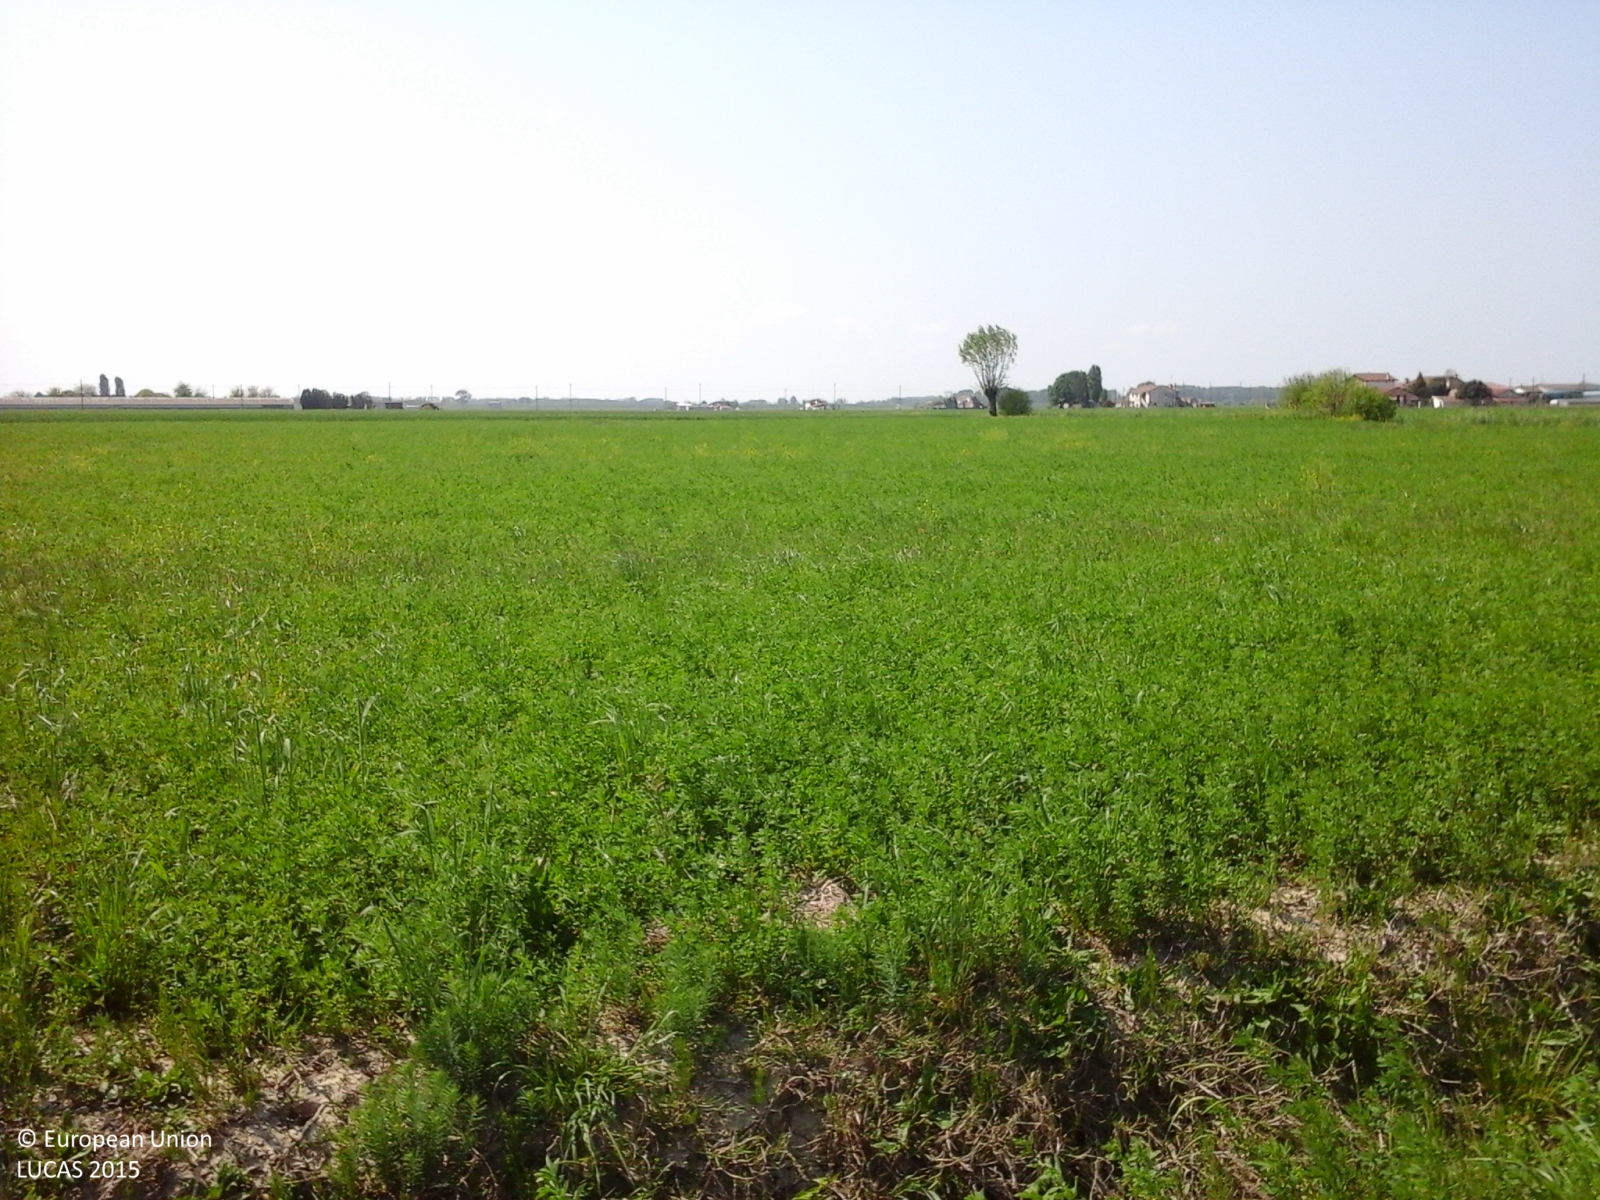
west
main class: Cropland
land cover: Lucerne
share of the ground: > 75 %
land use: Agriculture (excluding fallow land and kitchen gardens)
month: April
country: IT
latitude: 44.8840
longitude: 12.3126
